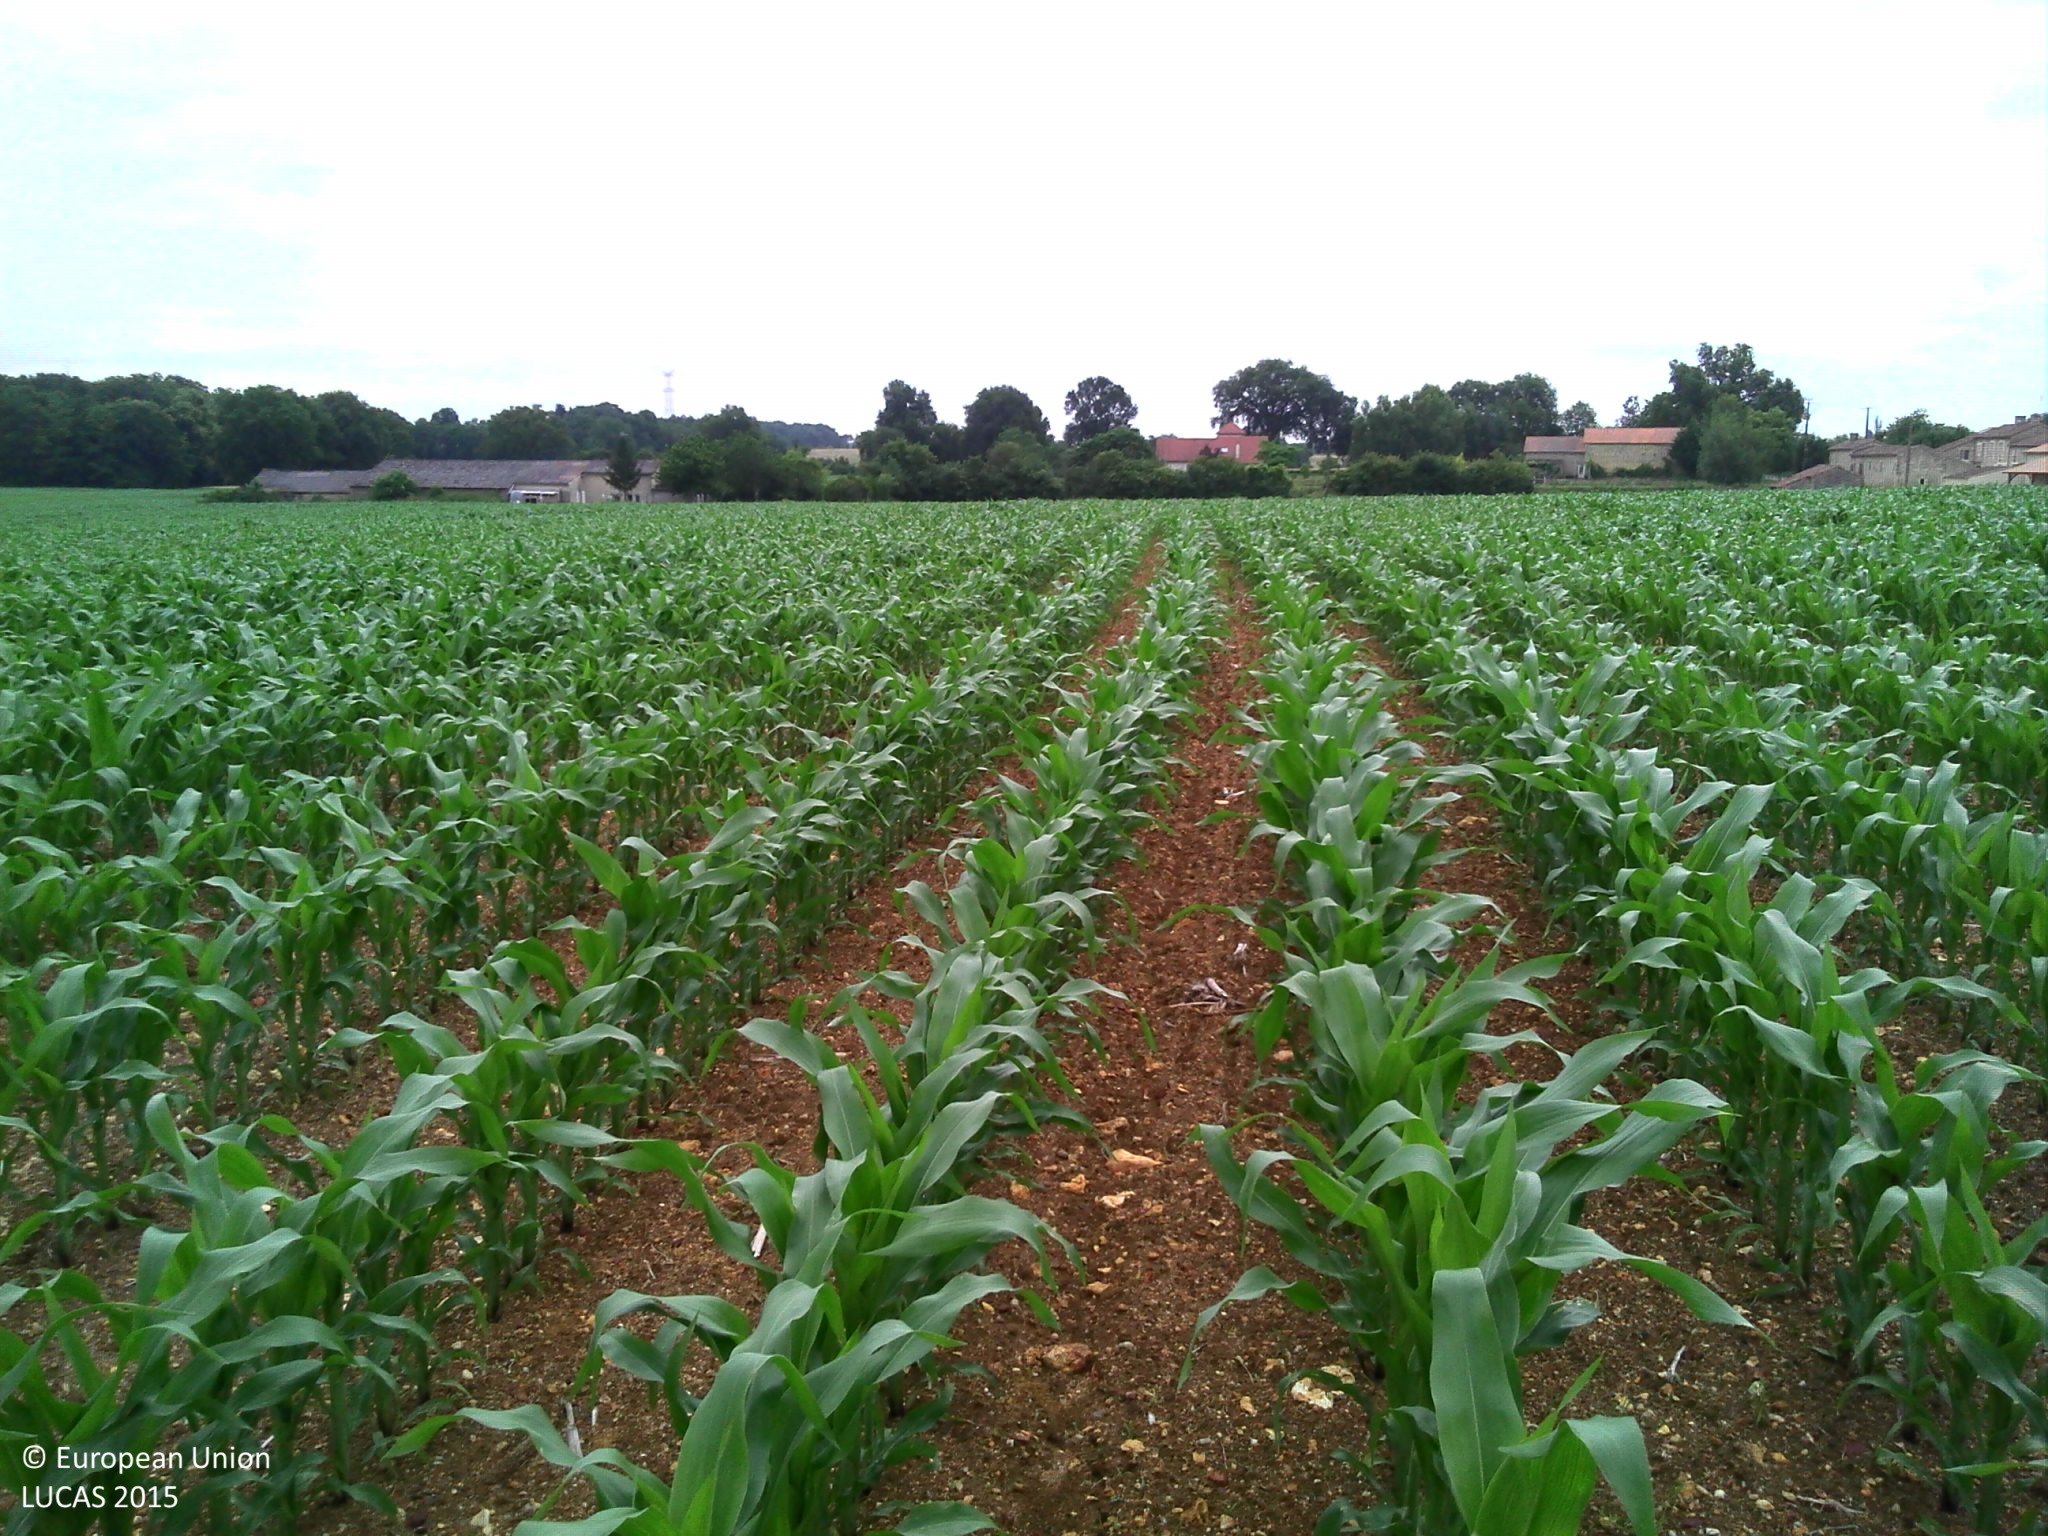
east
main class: Cropland
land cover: Maize
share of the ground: 50 - 75 %
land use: Agriculture (excluding fallow land and kitchen gardens)
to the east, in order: Maize; Managed hedges; Grass margins; Paved roads, cycling and walking lanes; Grass margins; Managed hedges; Fences; Shruby margins; Inland fresh water bodies
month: June
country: FR
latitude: 46.4928
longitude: 0.5372
